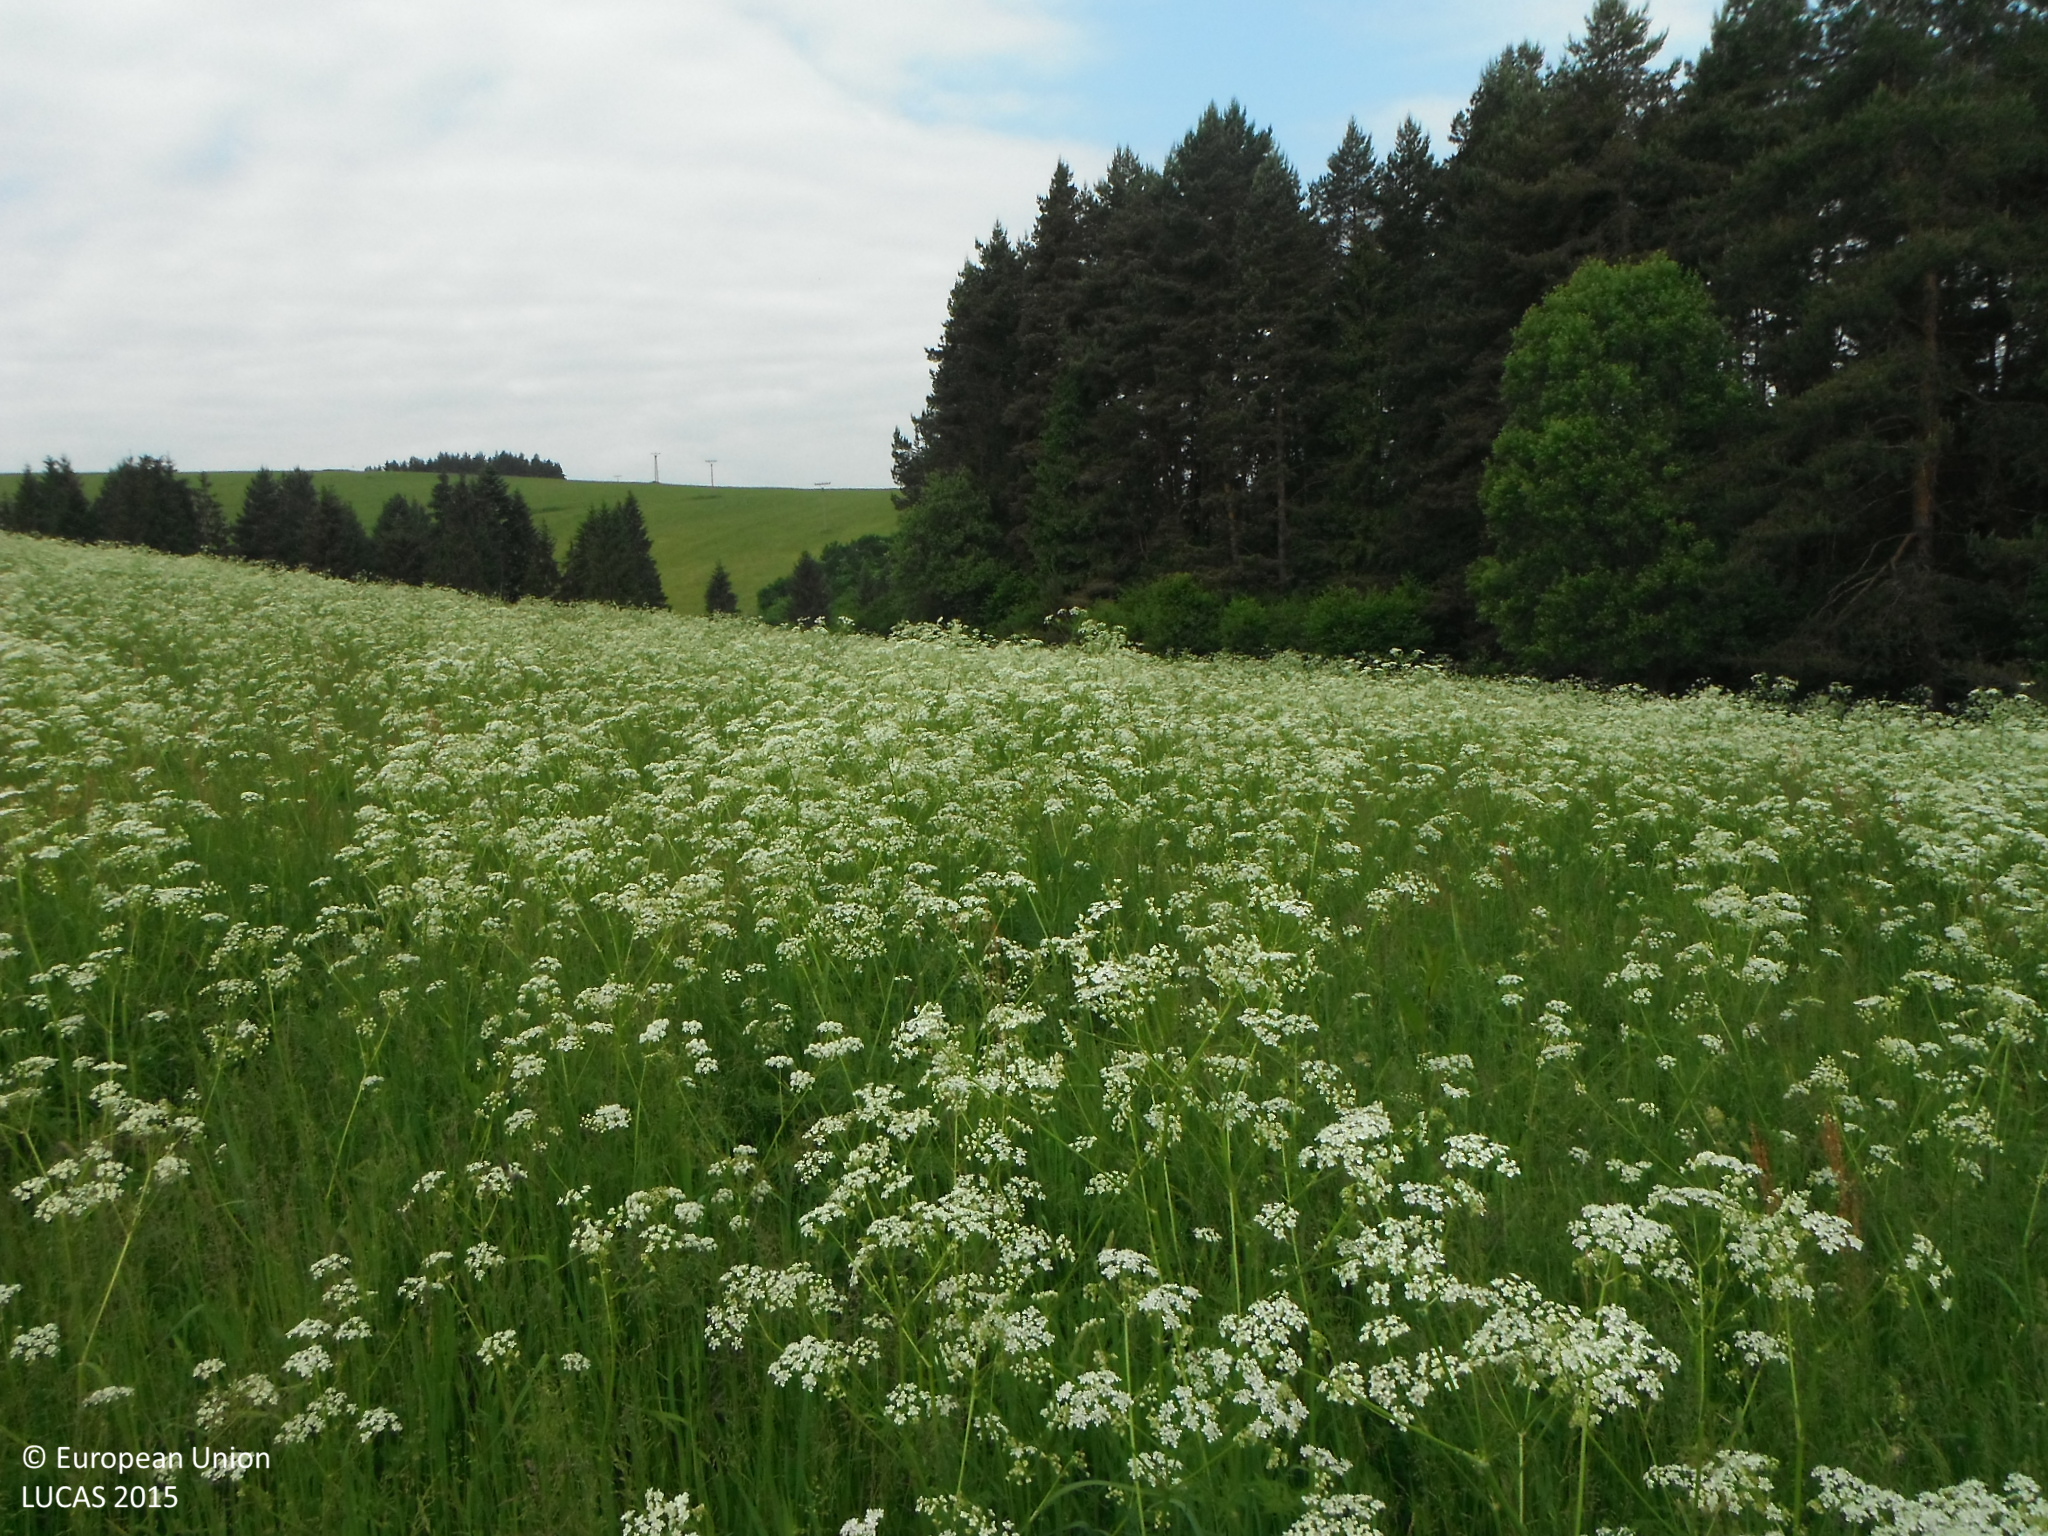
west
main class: Grassland
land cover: Grassland without tree/shrub cover
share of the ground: > 75 %
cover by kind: herbaceous plants 100 %
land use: Agriculture (excluding fallow land and kitchen gardens)
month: June
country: SK
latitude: 49.3827
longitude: 20.3804
